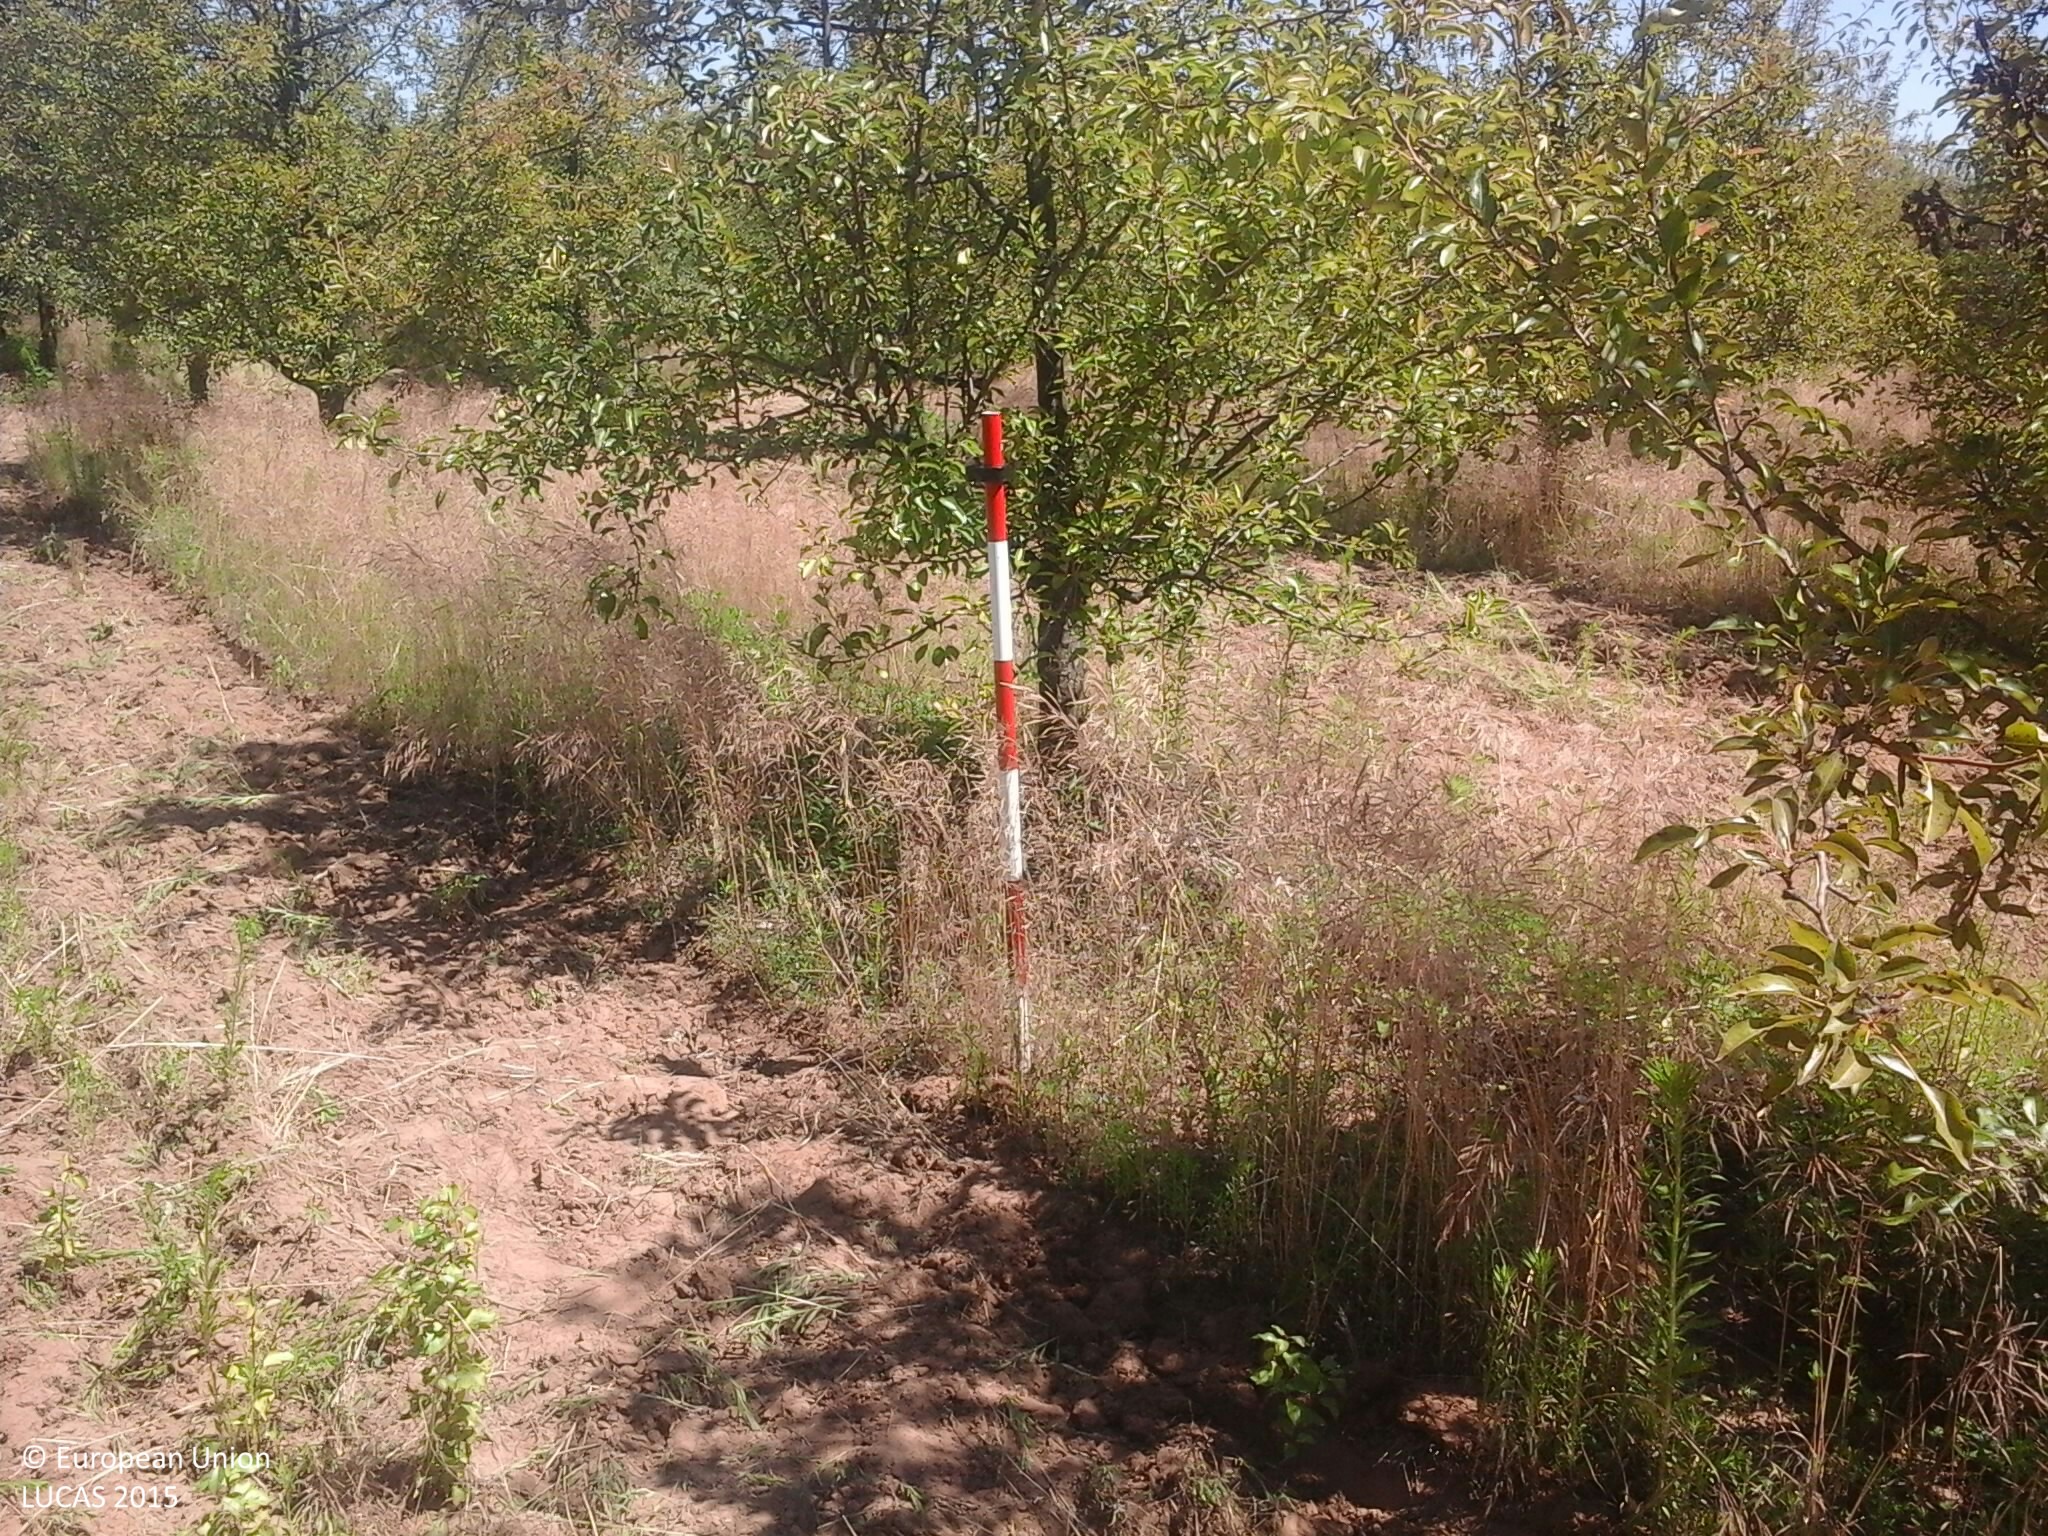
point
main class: Cropland
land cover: Pear fruit
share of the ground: 10 - 25 %
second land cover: Grassland without tree/shrub cover
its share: 50 - 75 %
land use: Agriculture (excluding fallow land and kitchen gardens)
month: July
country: HU
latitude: 47.8248
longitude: 21.7895
